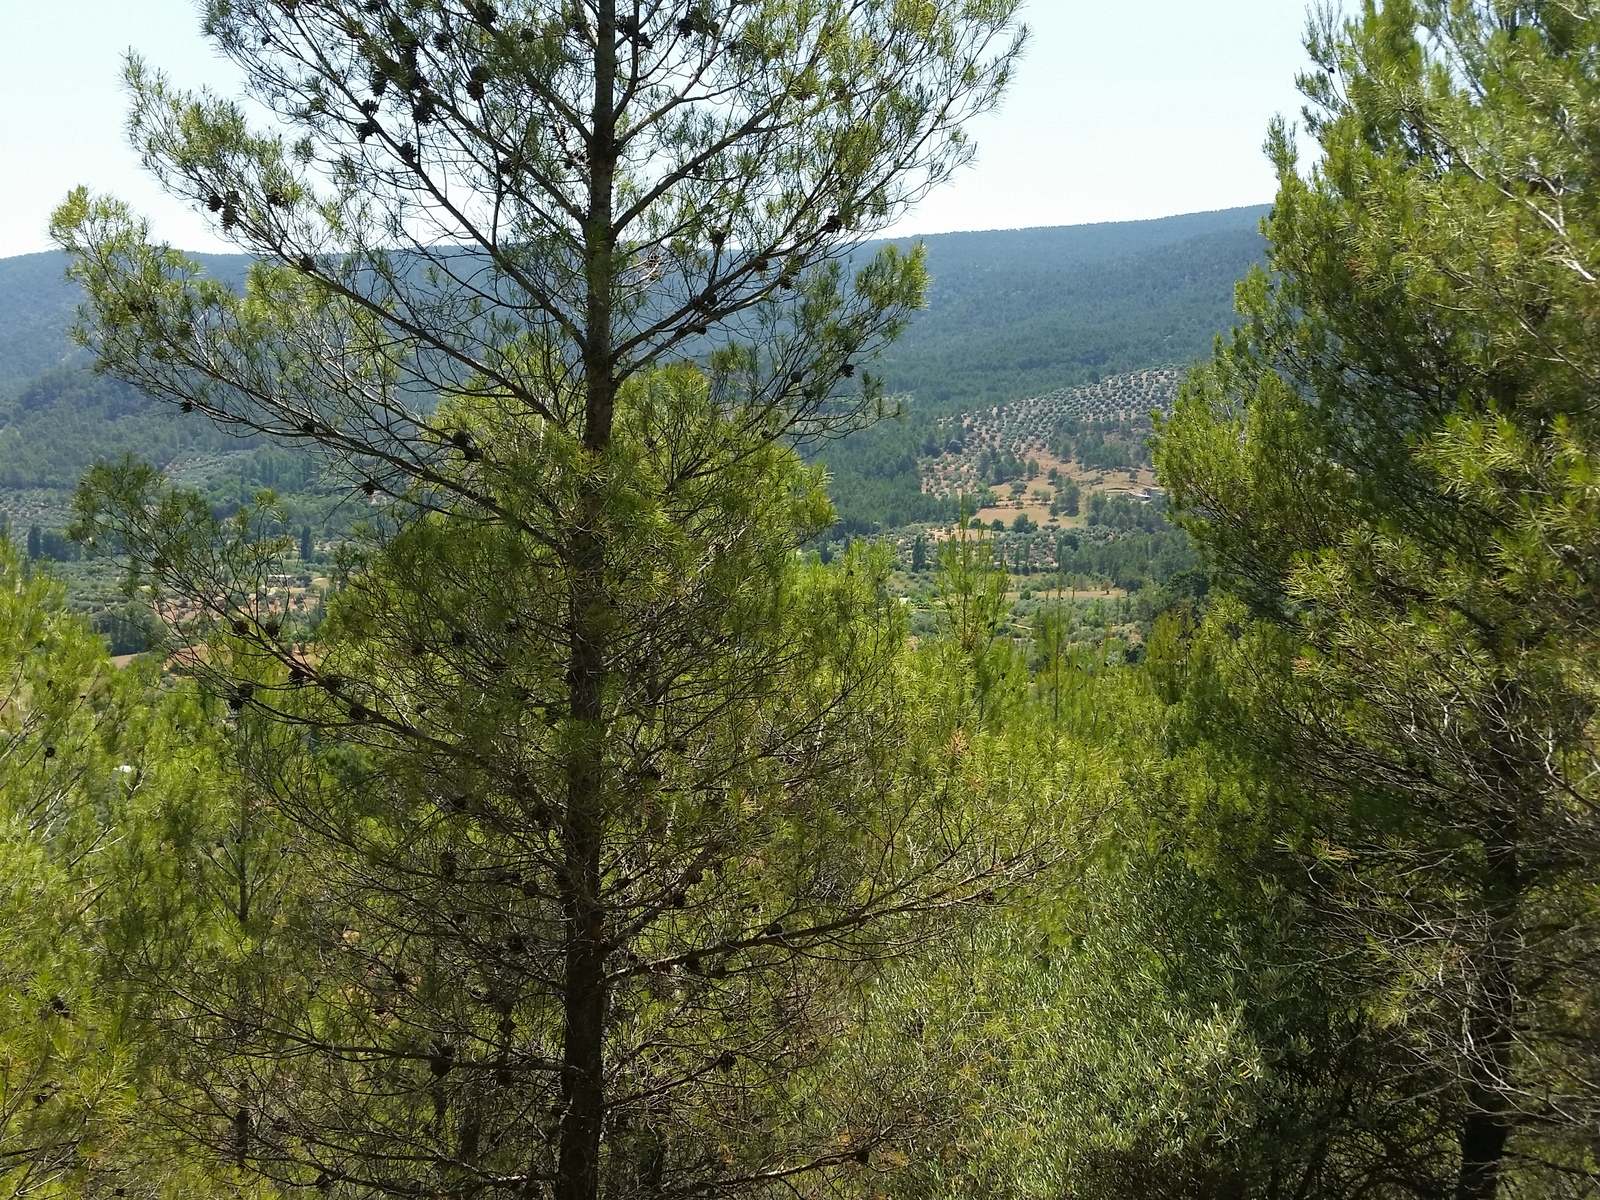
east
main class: Woodland
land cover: Pine dominated coniferous woodland
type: coniferous forest of the mediterranean region
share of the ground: 50 - 75 %
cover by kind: coniferous forest trees 70 %, consolidated bare surface 15 %, shrubs 10 %, herbaceous plants 5 %
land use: Semi-natural and natural areas not in use
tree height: > 5 m
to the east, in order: Pine dominated coniferous woodland; Olive groves; Tracks; Olive groves; Ditches and canals; Olive groves; Grass margins; Spontaneously vegetated surfaces
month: June
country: ES
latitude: 38.3955
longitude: -2.5586
